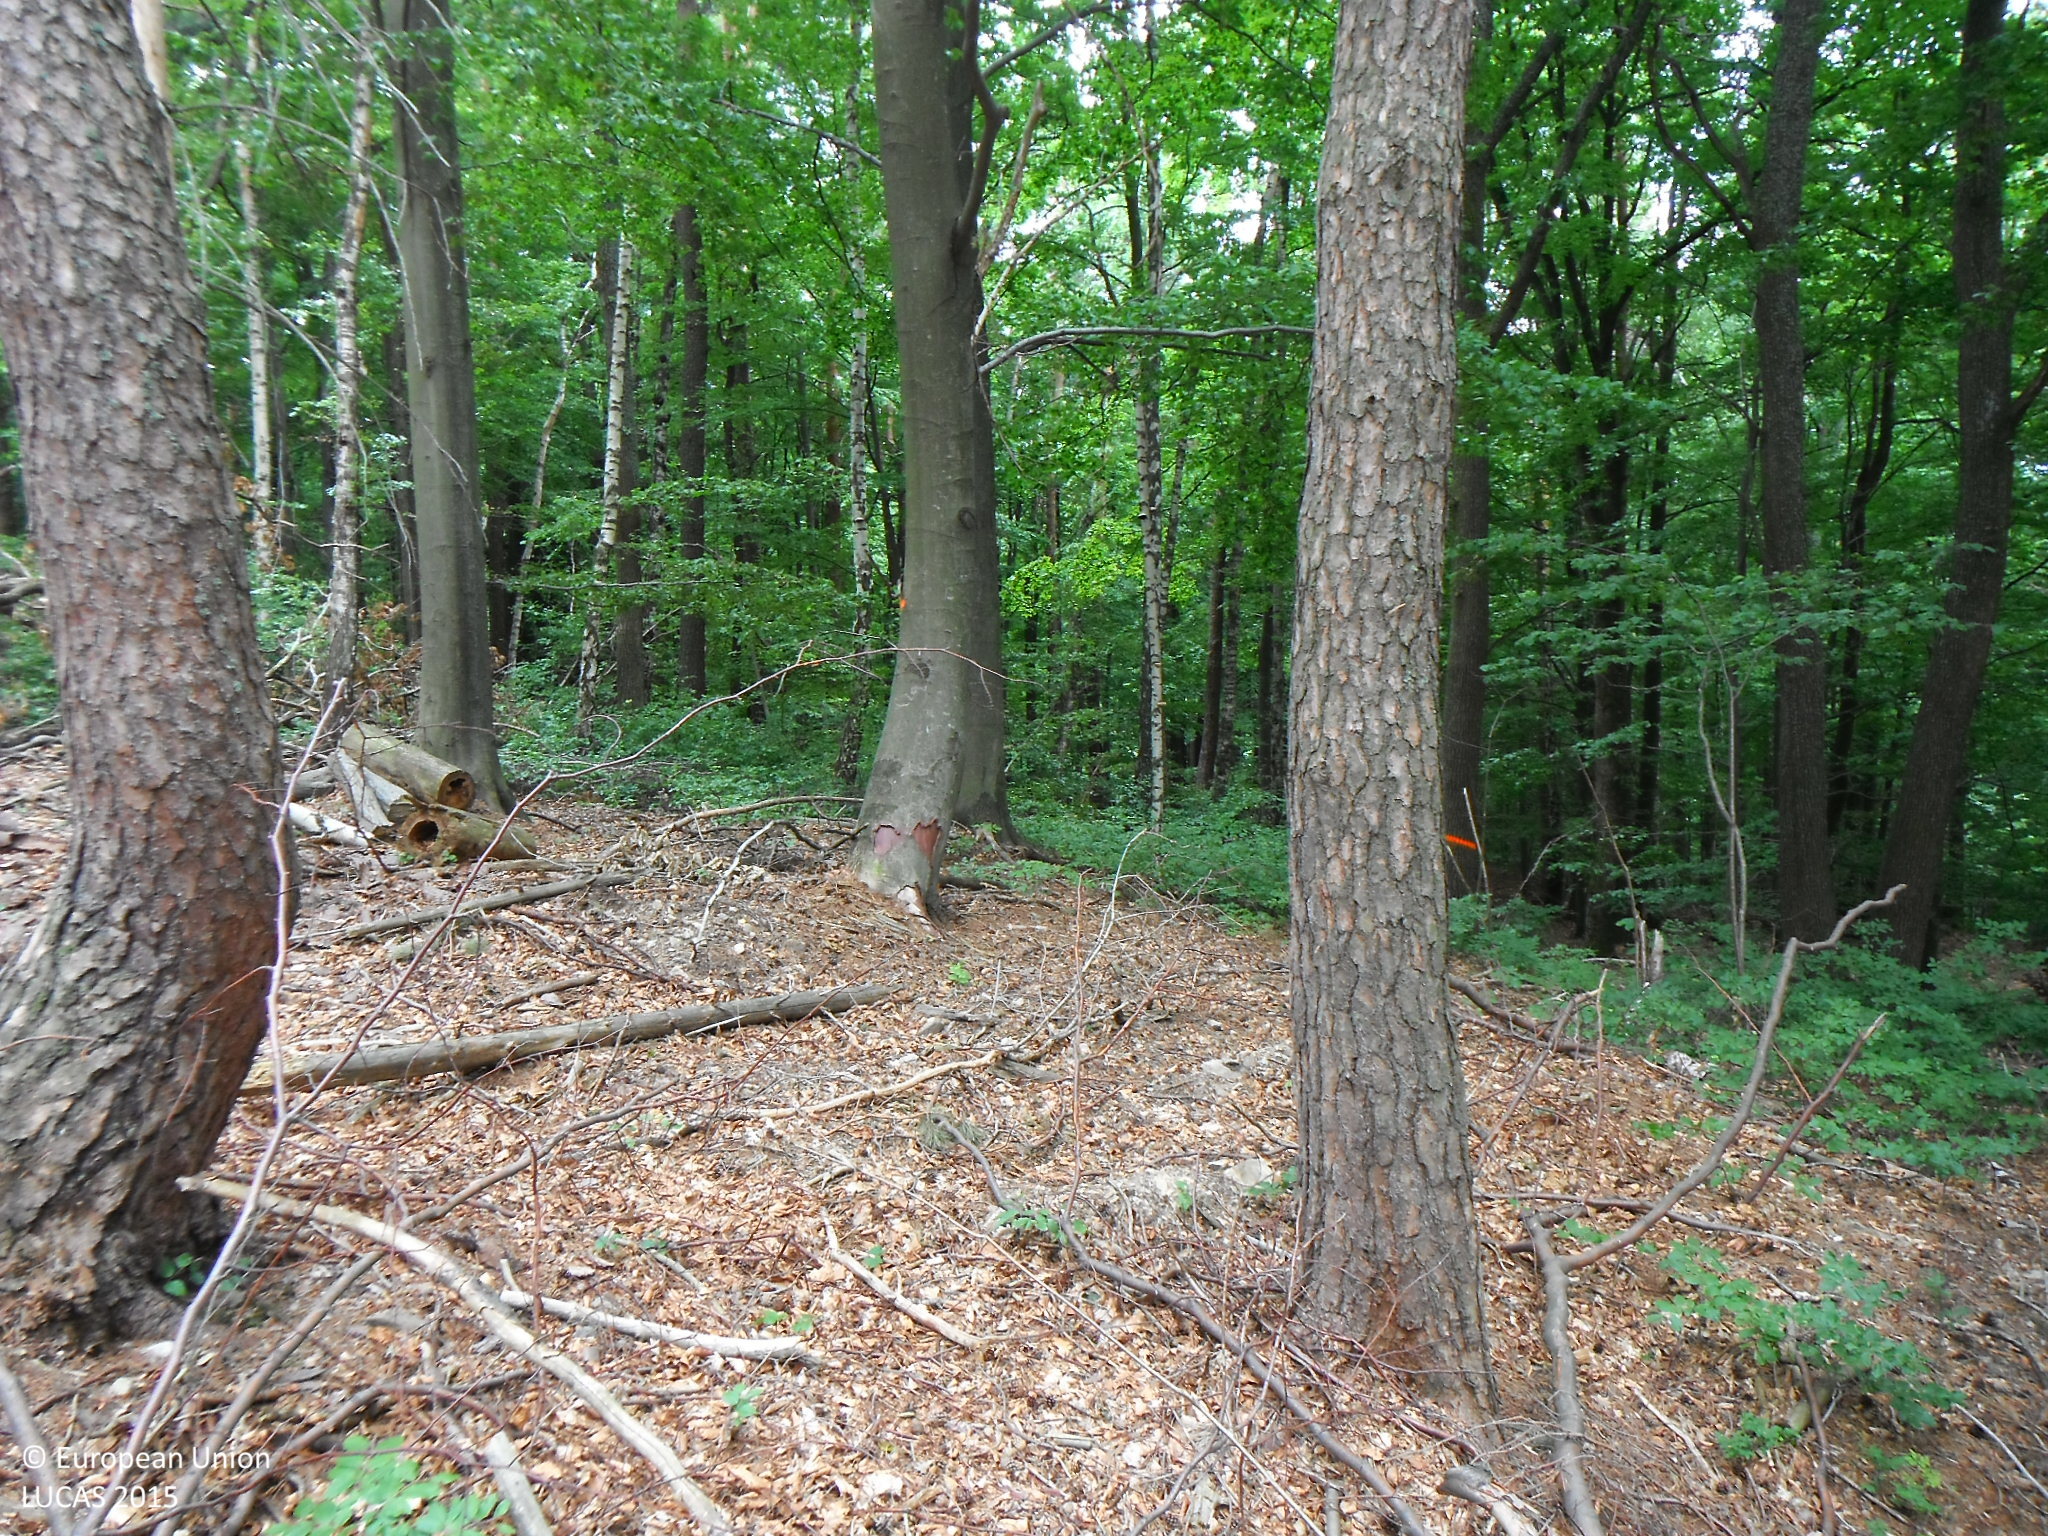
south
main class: Woodland
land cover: Pine dominated mixed woodland
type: hemiboreal forest and nemoral coniferous forest and mixed broadleaved-coniferous forest
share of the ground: 50 - 75 %
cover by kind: coniferous forest trees 65 %, broadleaved forest trees 35 %
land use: Forestry
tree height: > 5 m
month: July
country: SK
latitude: 48.7383
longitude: 21.0423
